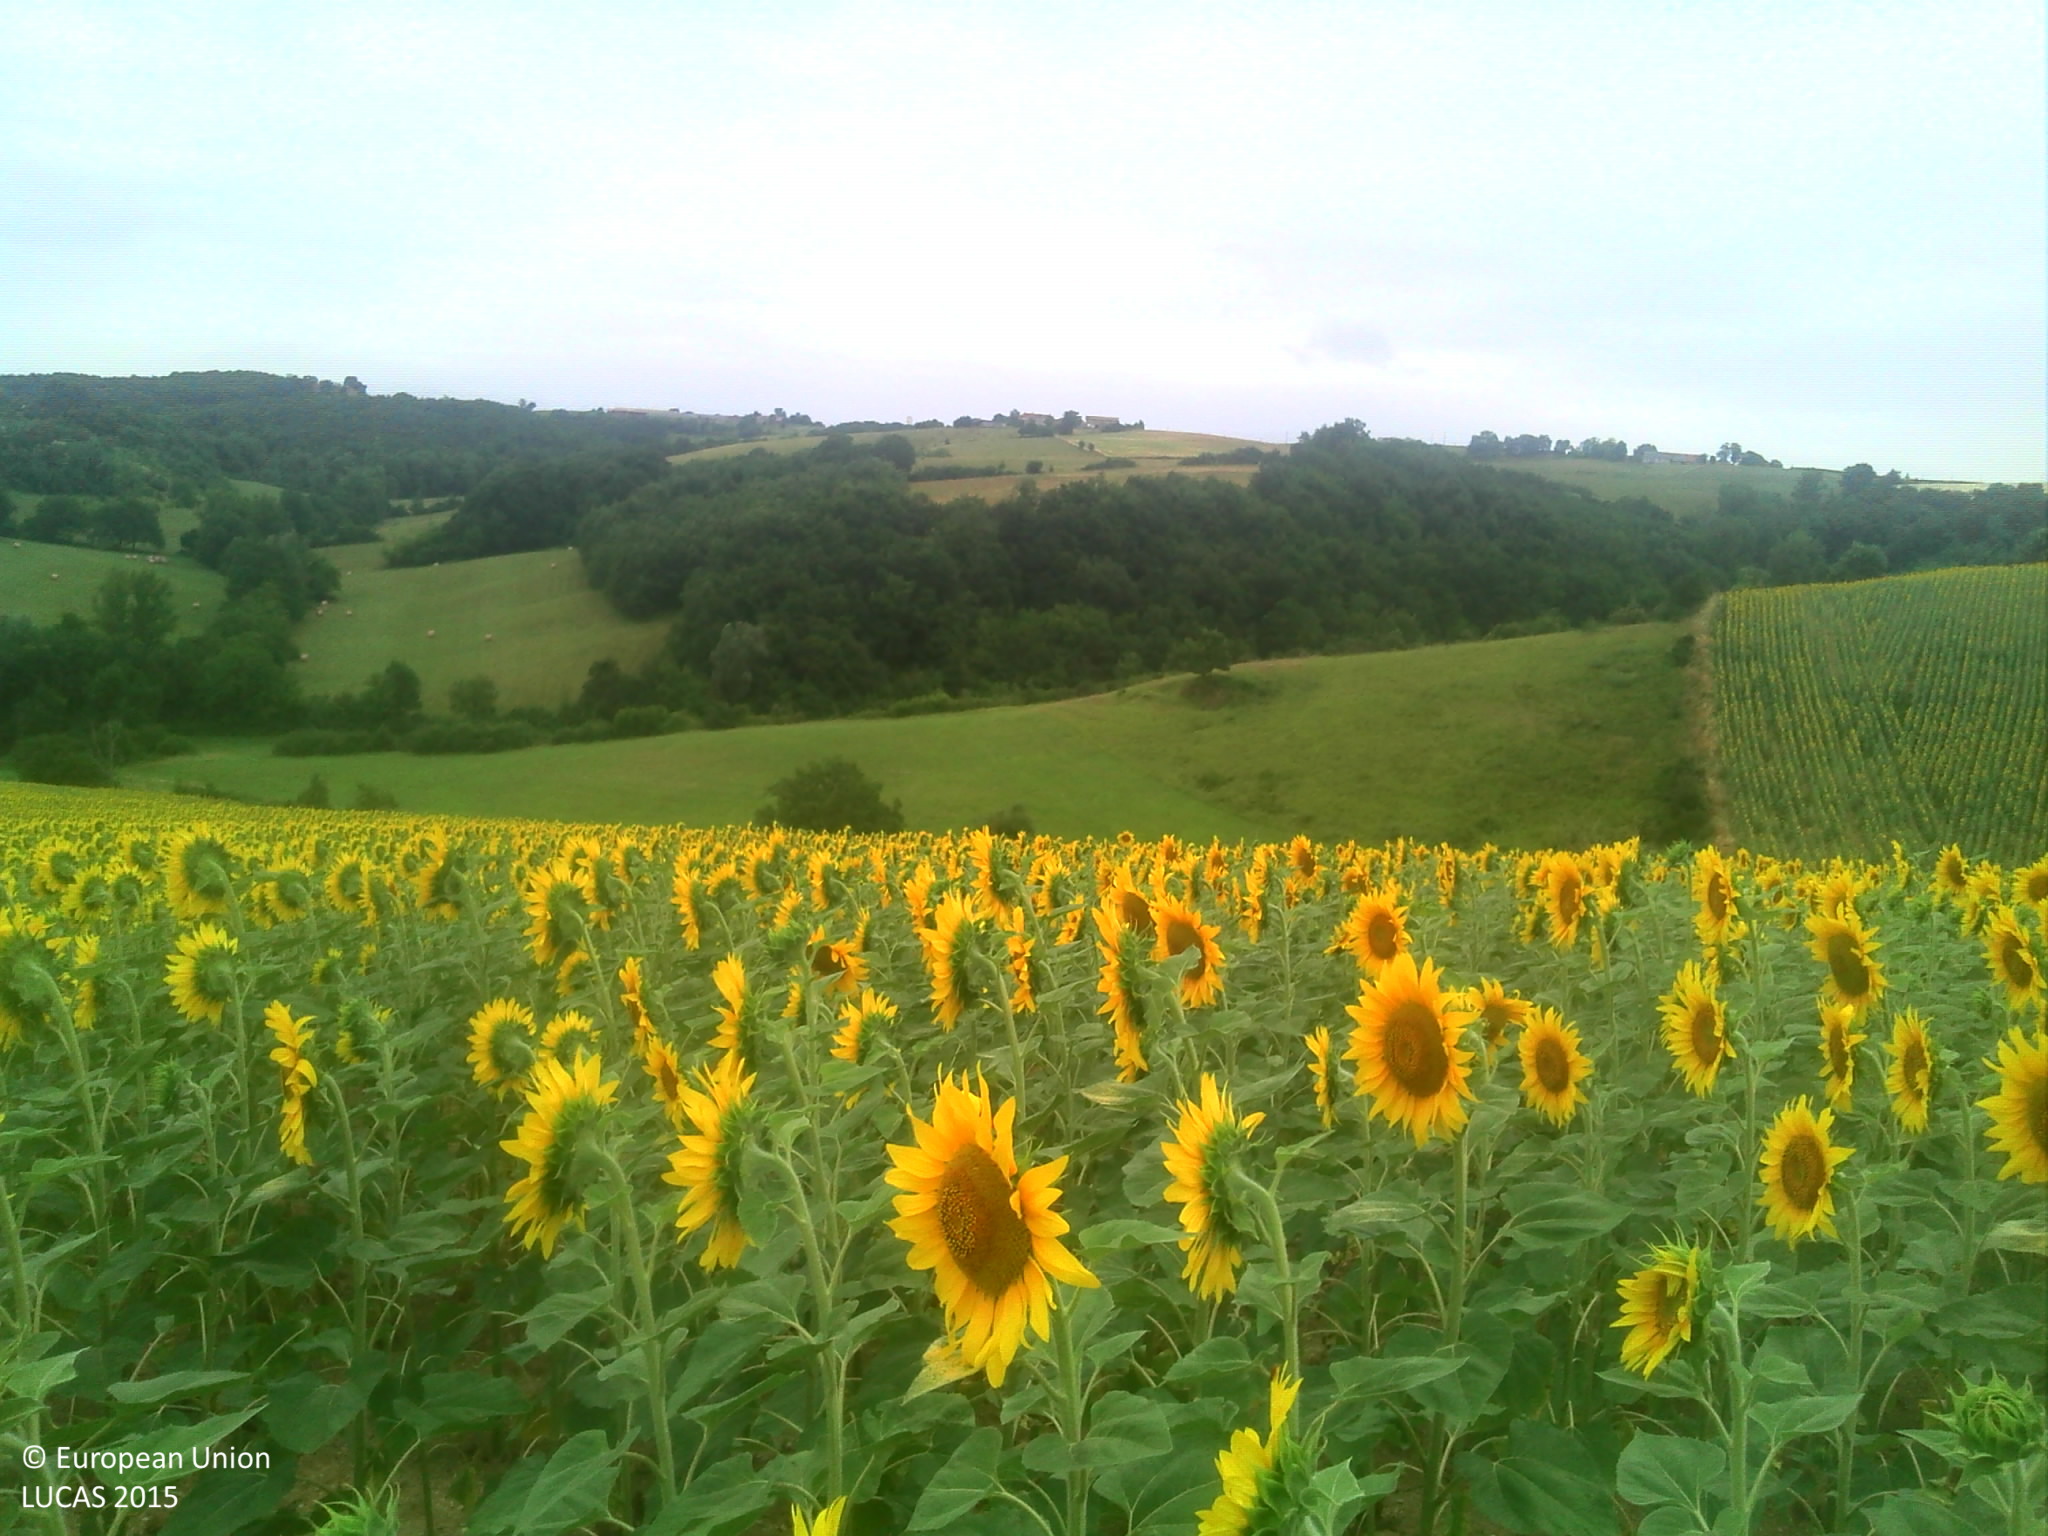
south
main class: Cropland
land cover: Sunflower
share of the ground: > 75 %
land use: Agriculture (excluding fallow land and kitchen gardens)
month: July
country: FR
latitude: 43.2194
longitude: 1.4736
